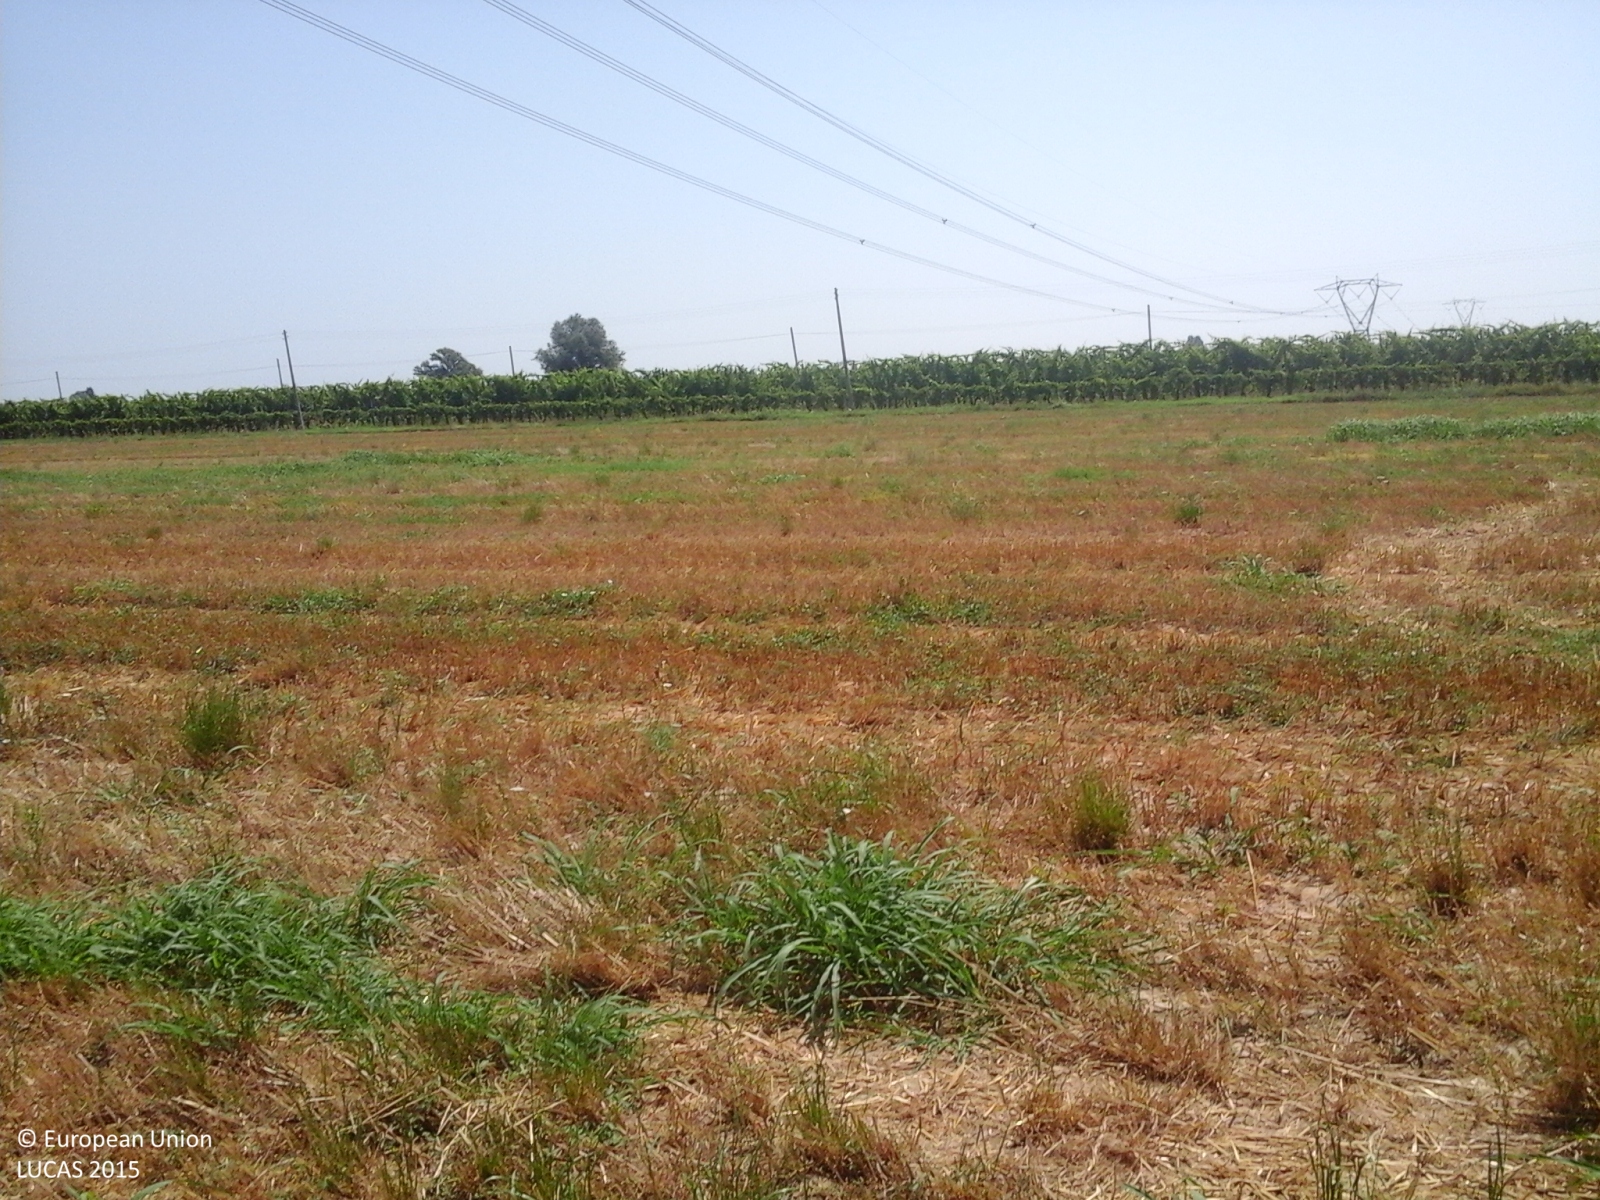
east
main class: Cropland
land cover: Common wheat
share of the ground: > 75 %
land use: Agriculture (excluding fallow land and kitchen gardens)
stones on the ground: < 10 %
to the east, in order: Common wheat; Electric lines; Common wheat; Grass margins; Ditches and canals; Grass margins; Paved roads, cycling and walking lanes; Grass margins; Ditches and canals; Electric lines; Grass margins; Vineyards; Maize; Ditches and canals; Vineyards
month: July
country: IT
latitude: 44.4600
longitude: 11.8687
